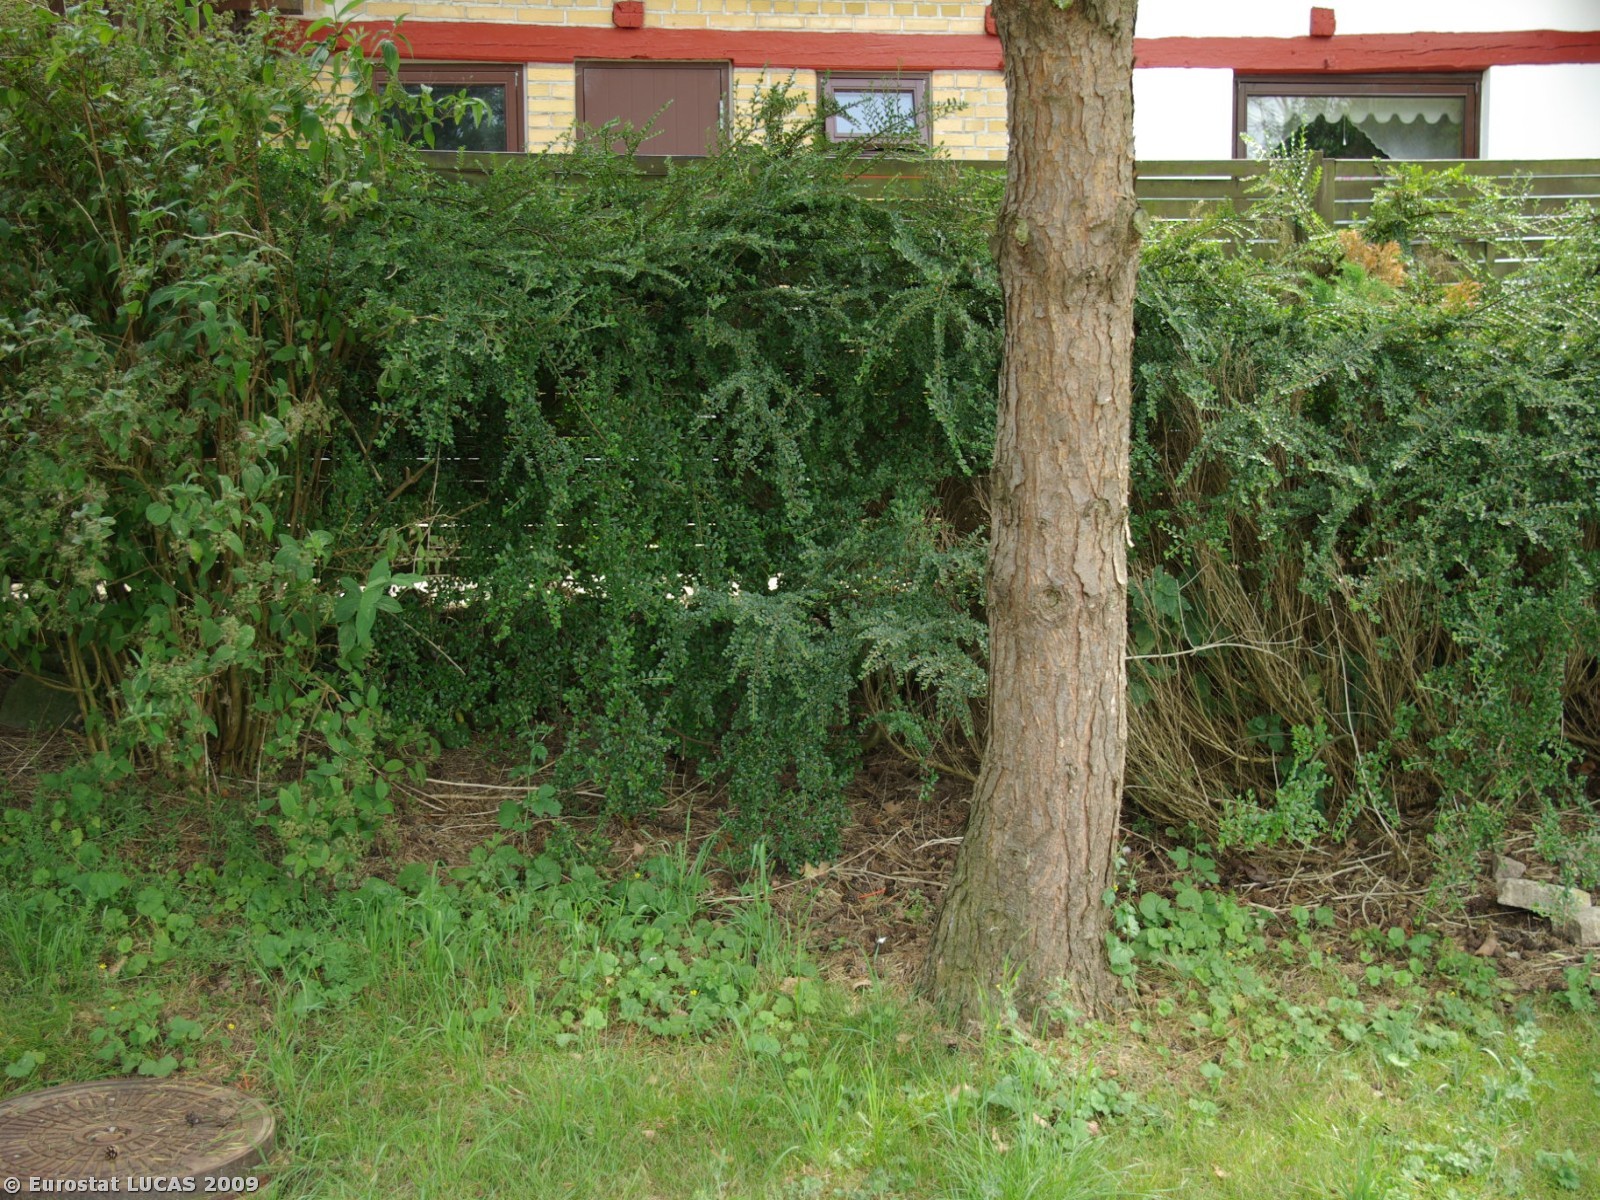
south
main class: Cropland
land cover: Common wheat
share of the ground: > 75 %
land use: Agriculture (excluding fallow land and kitchen gardens)
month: July
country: DK
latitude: 55.0014
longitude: 9.9219
